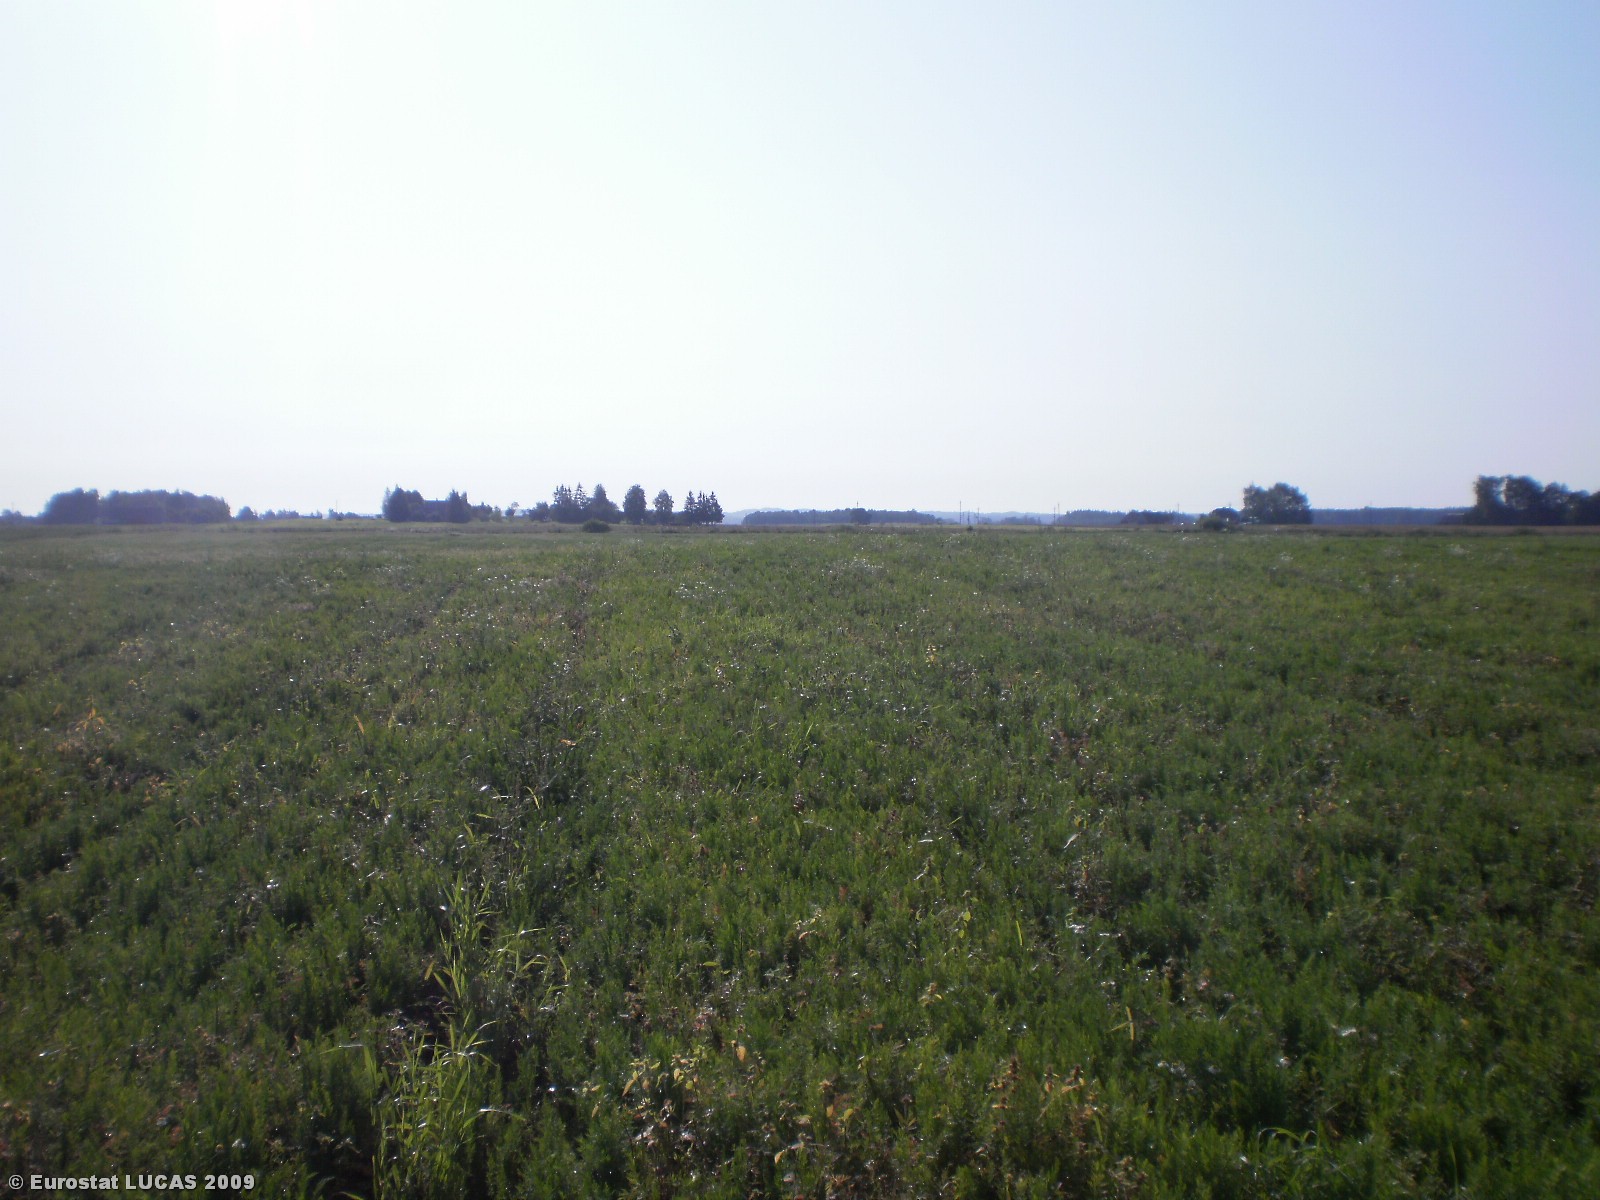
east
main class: Cropland
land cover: Other cereals
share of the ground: > 75 %
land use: Agriculture (excluding fallow land and kitchen gardens)
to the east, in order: Other cereals; Rape and turnip rape
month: August
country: LT
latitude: 55.5381
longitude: 24.9908
